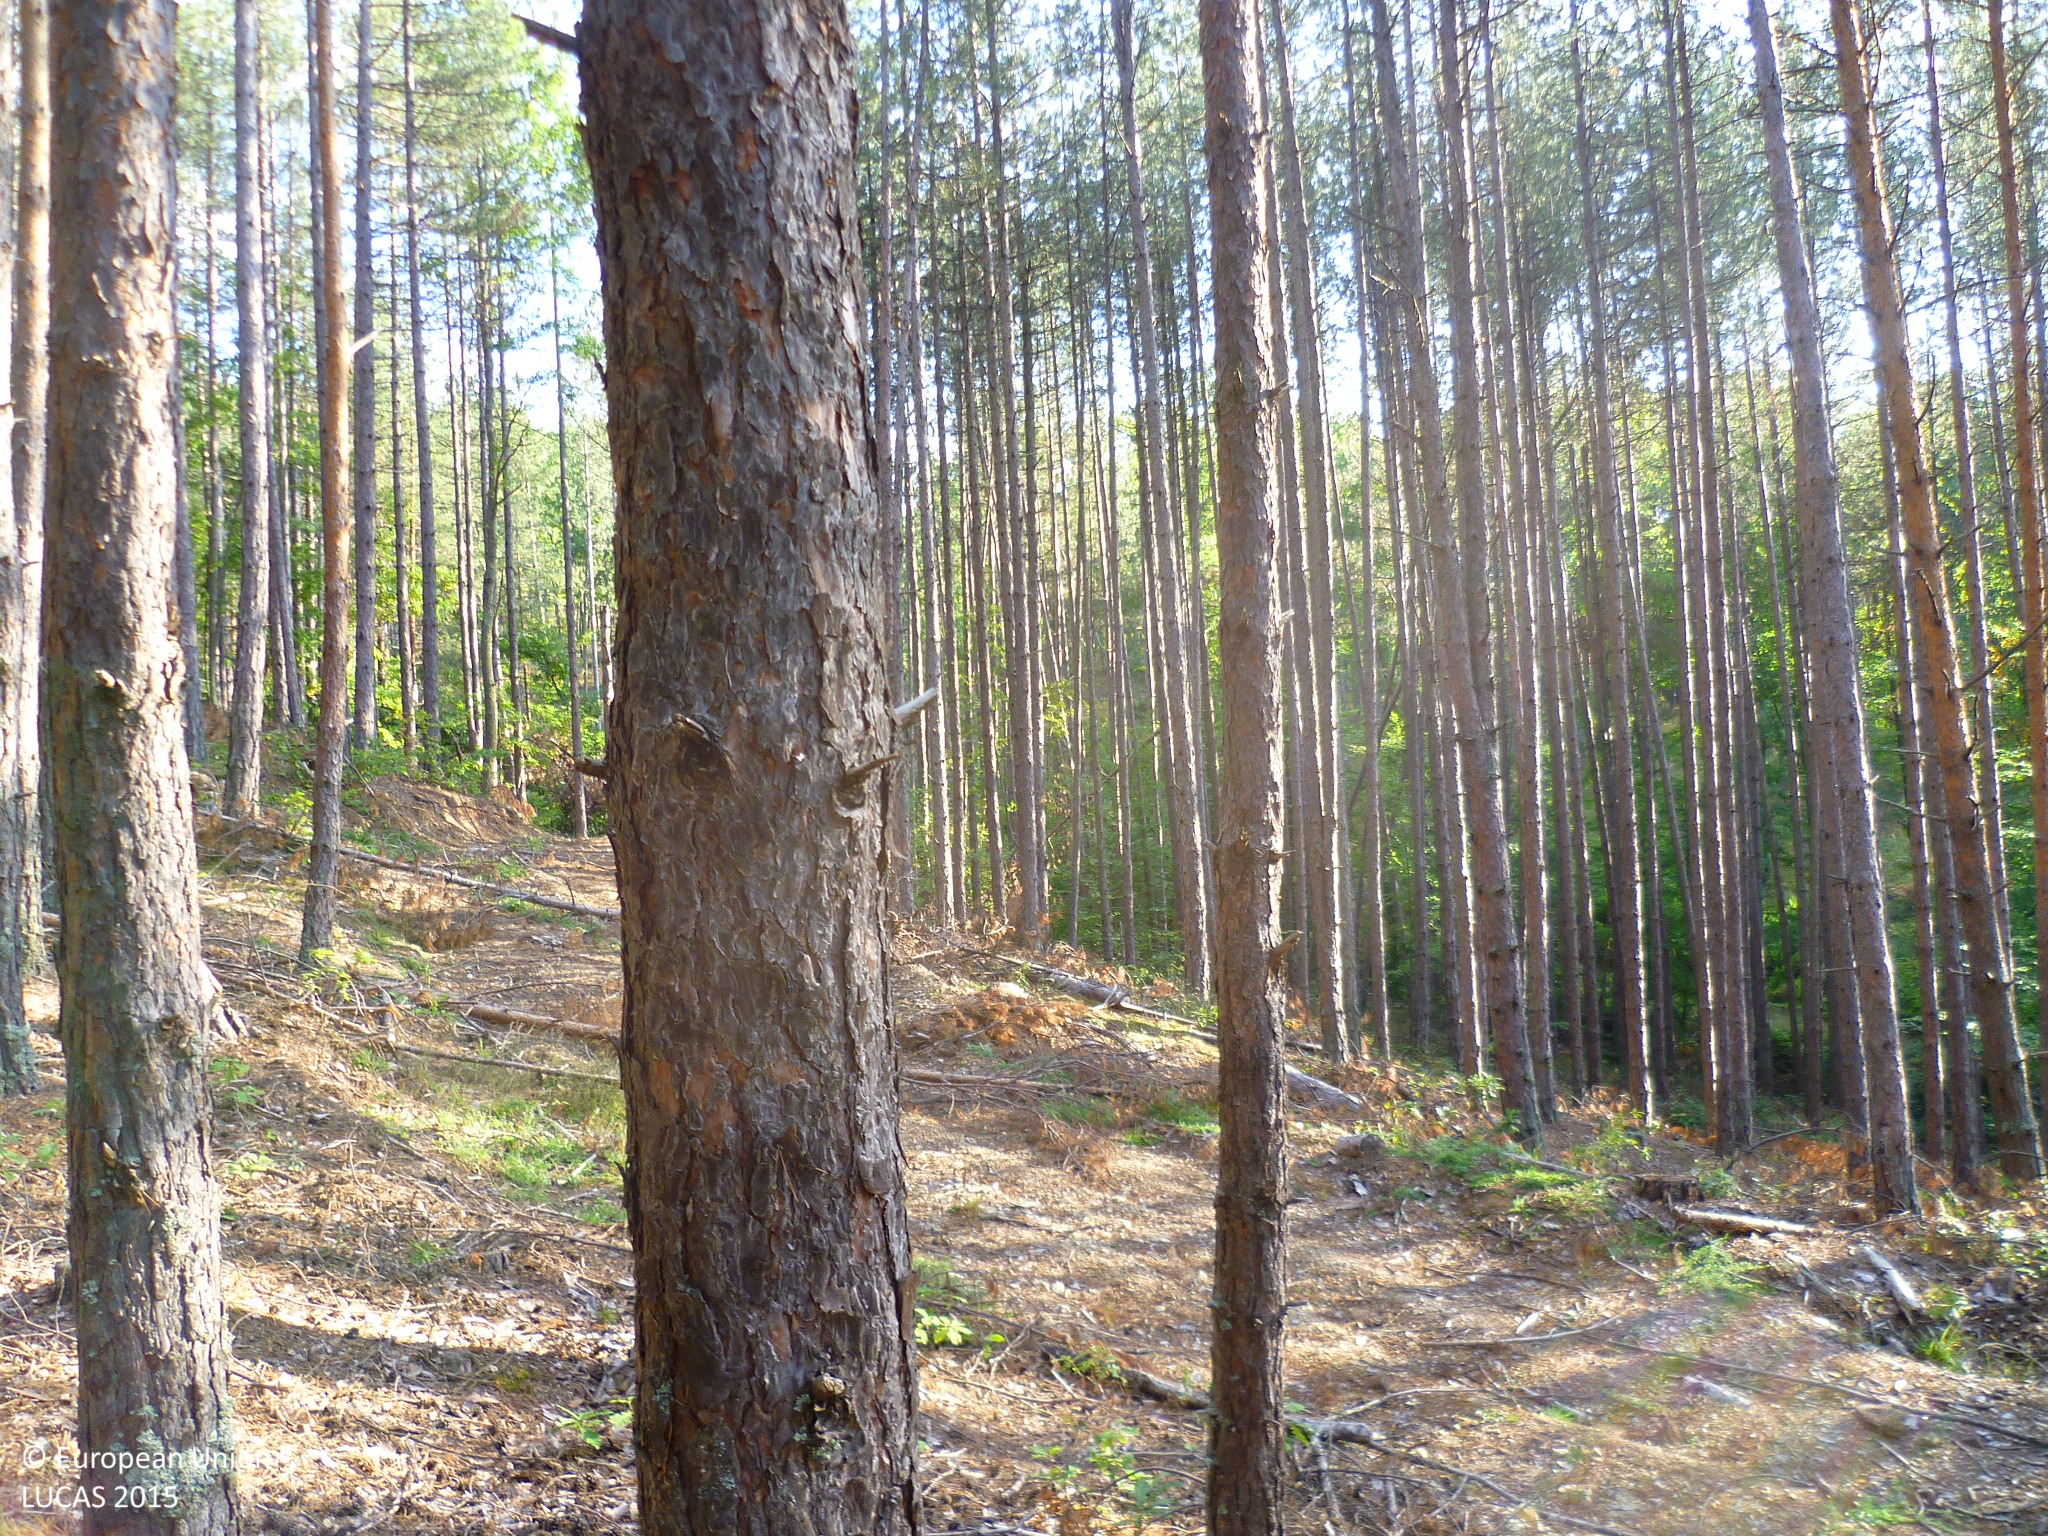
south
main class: Woodland
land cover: Pine dominated mixed woodland
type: hemiboreal forest and nemoral coniferous forest and mixed broadleaved-coniferous forest
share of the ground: > 75 %
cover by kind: coniferous forest trees 60 %, broadleaved forest trees 20 %, unconsolidated bare surface 15 %, herbaceous plants 5 %
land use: Forestry
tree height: > 5 m
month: October
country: BG
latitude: 42.7848
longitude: 22.6783
